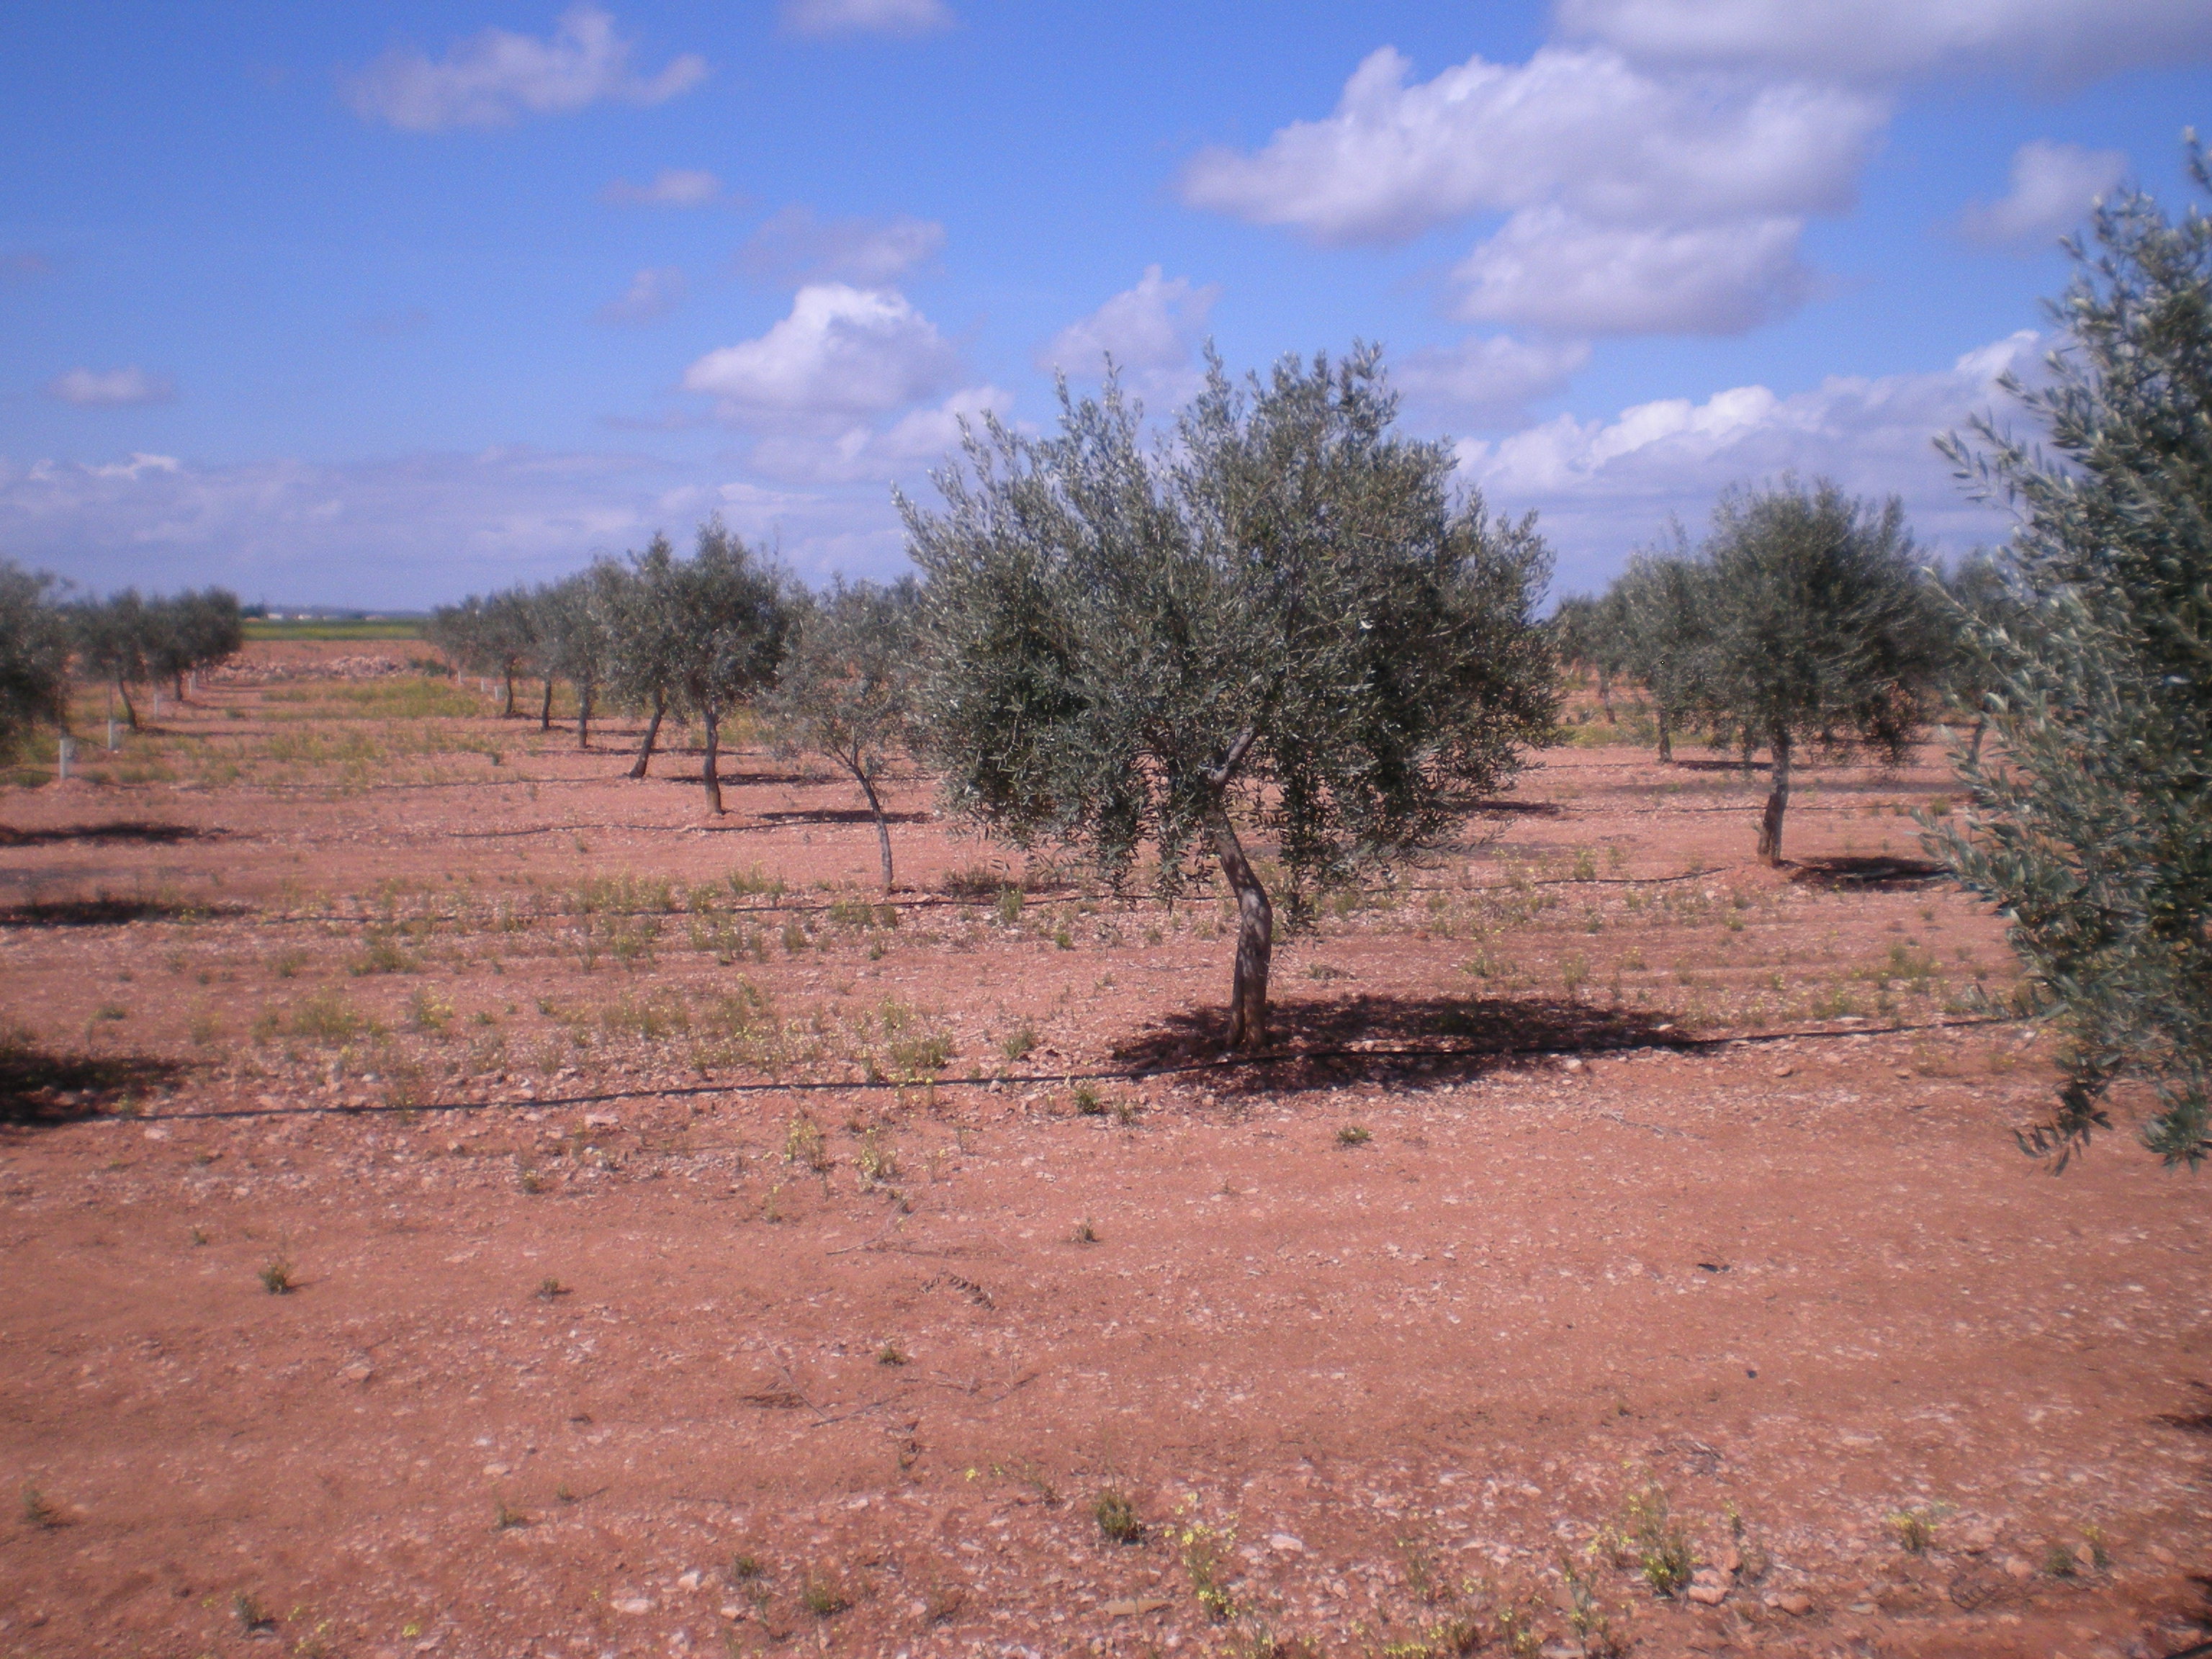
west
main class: Cropland
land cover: Olive groves
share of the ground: < 10 %
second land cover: Other bare soil
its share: > 75 %
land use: Agriculture (excluding fallow land and kitchen gardens)
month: April
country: ES
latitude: 38.9494
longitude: -3.5968
